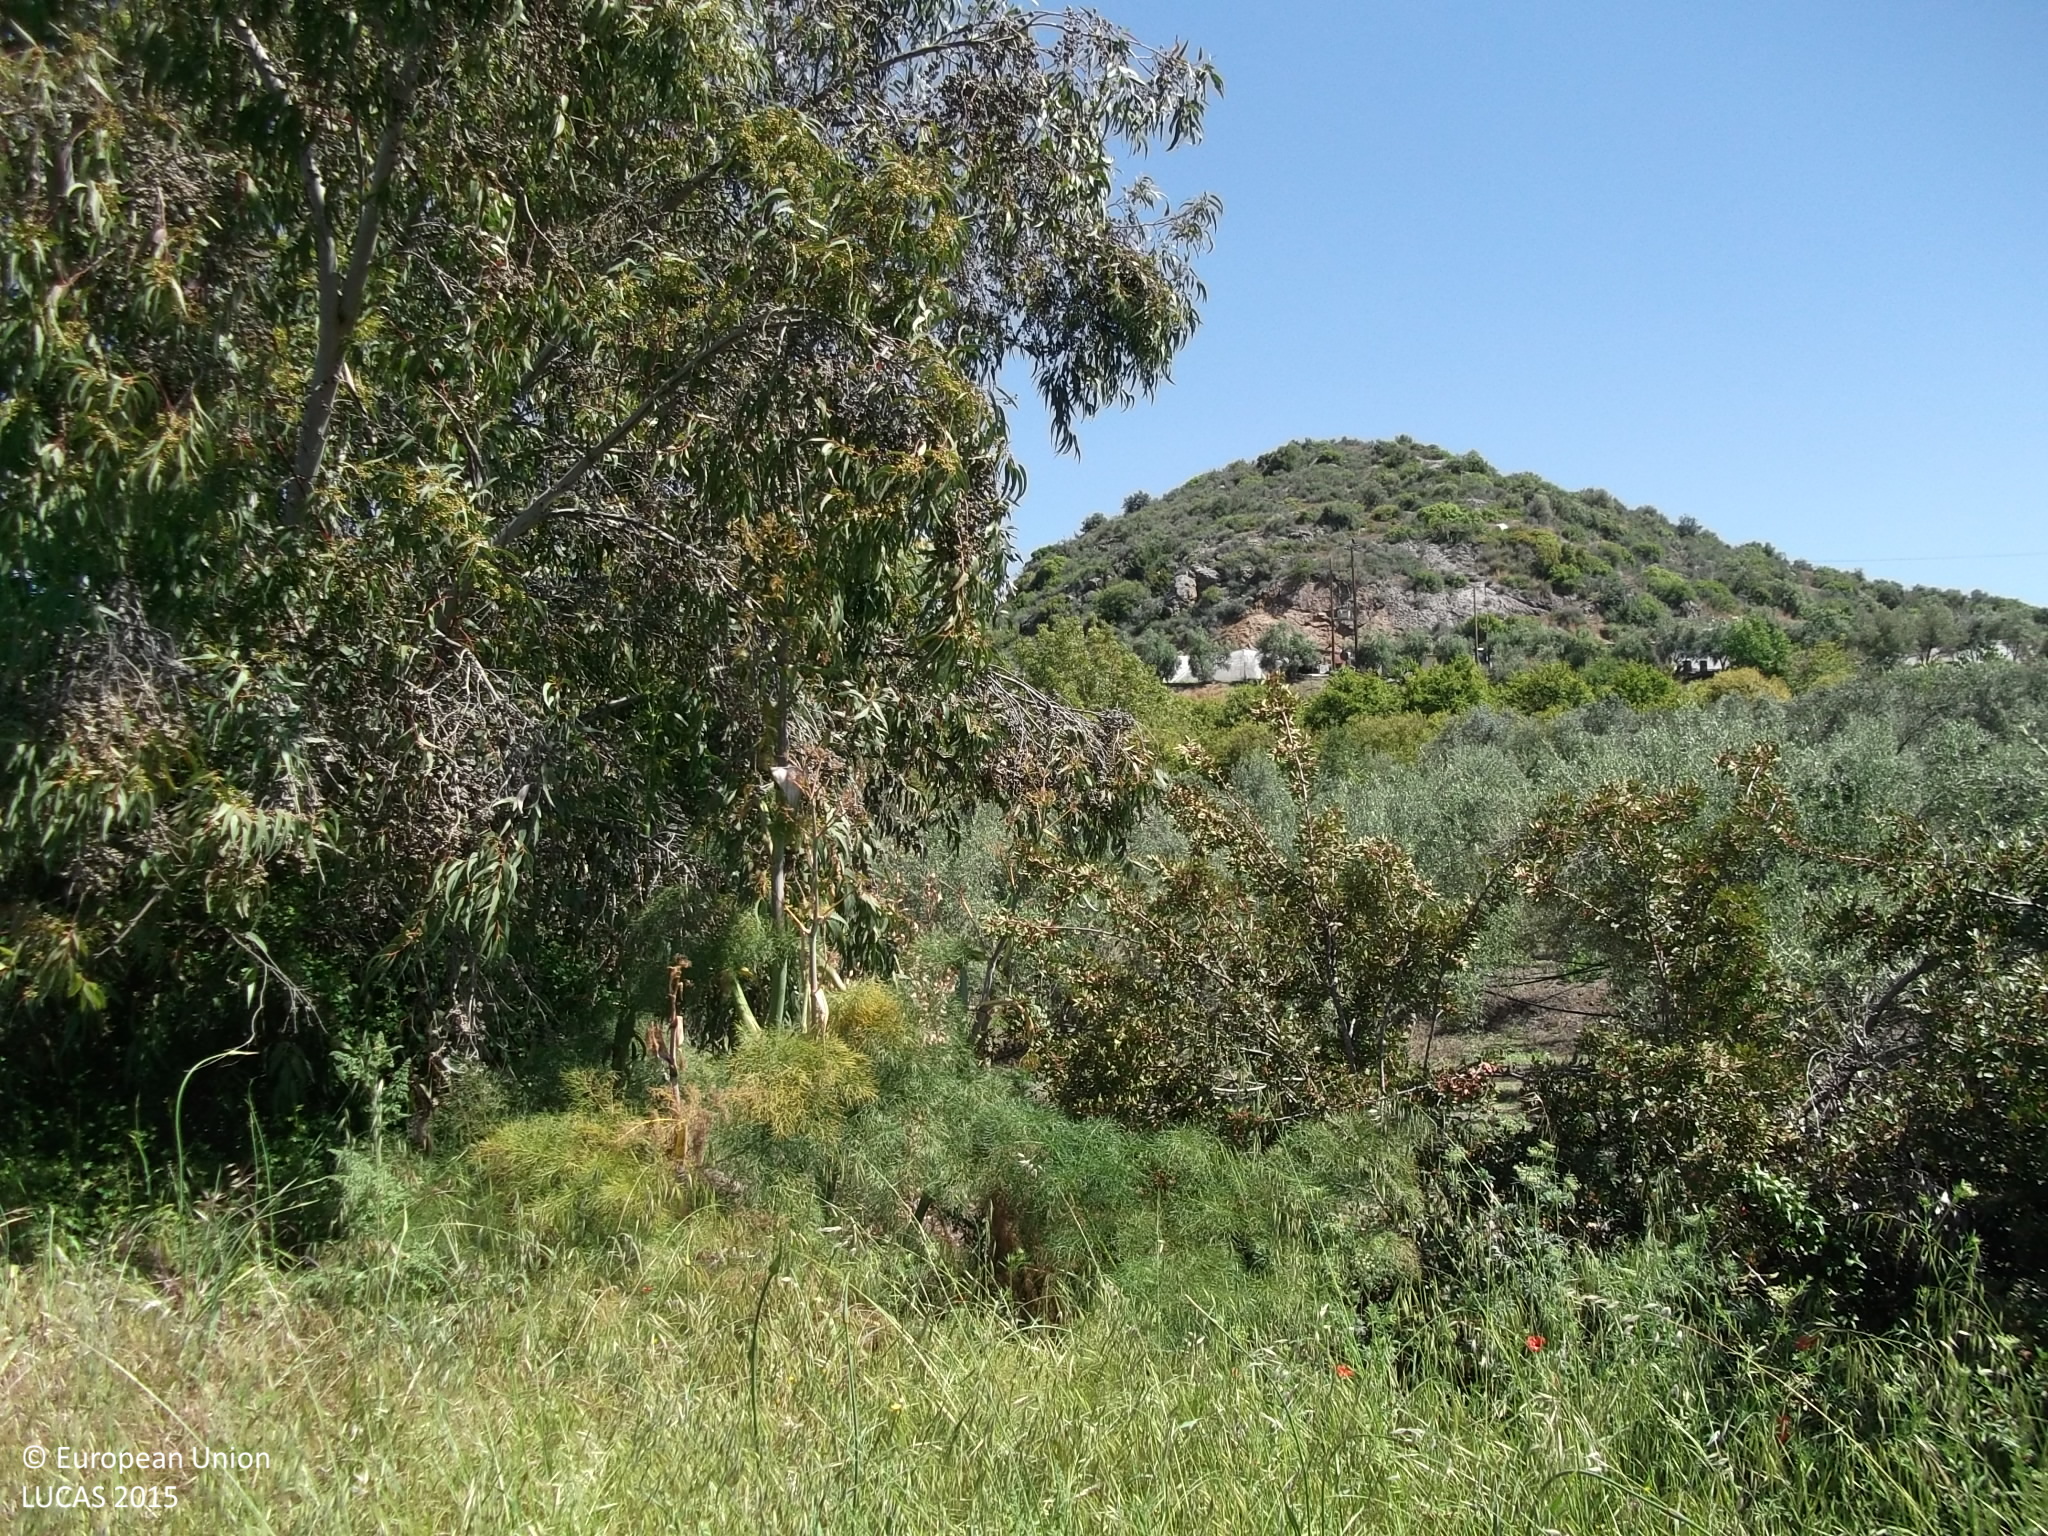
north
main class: Grassland
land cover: Spontaneously vegetated surfaces
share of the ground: > 75 %
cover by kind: herbaceous plants 100 %
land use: Fallow land
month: April
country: CY
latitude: 34.8432
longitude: 33.1737
